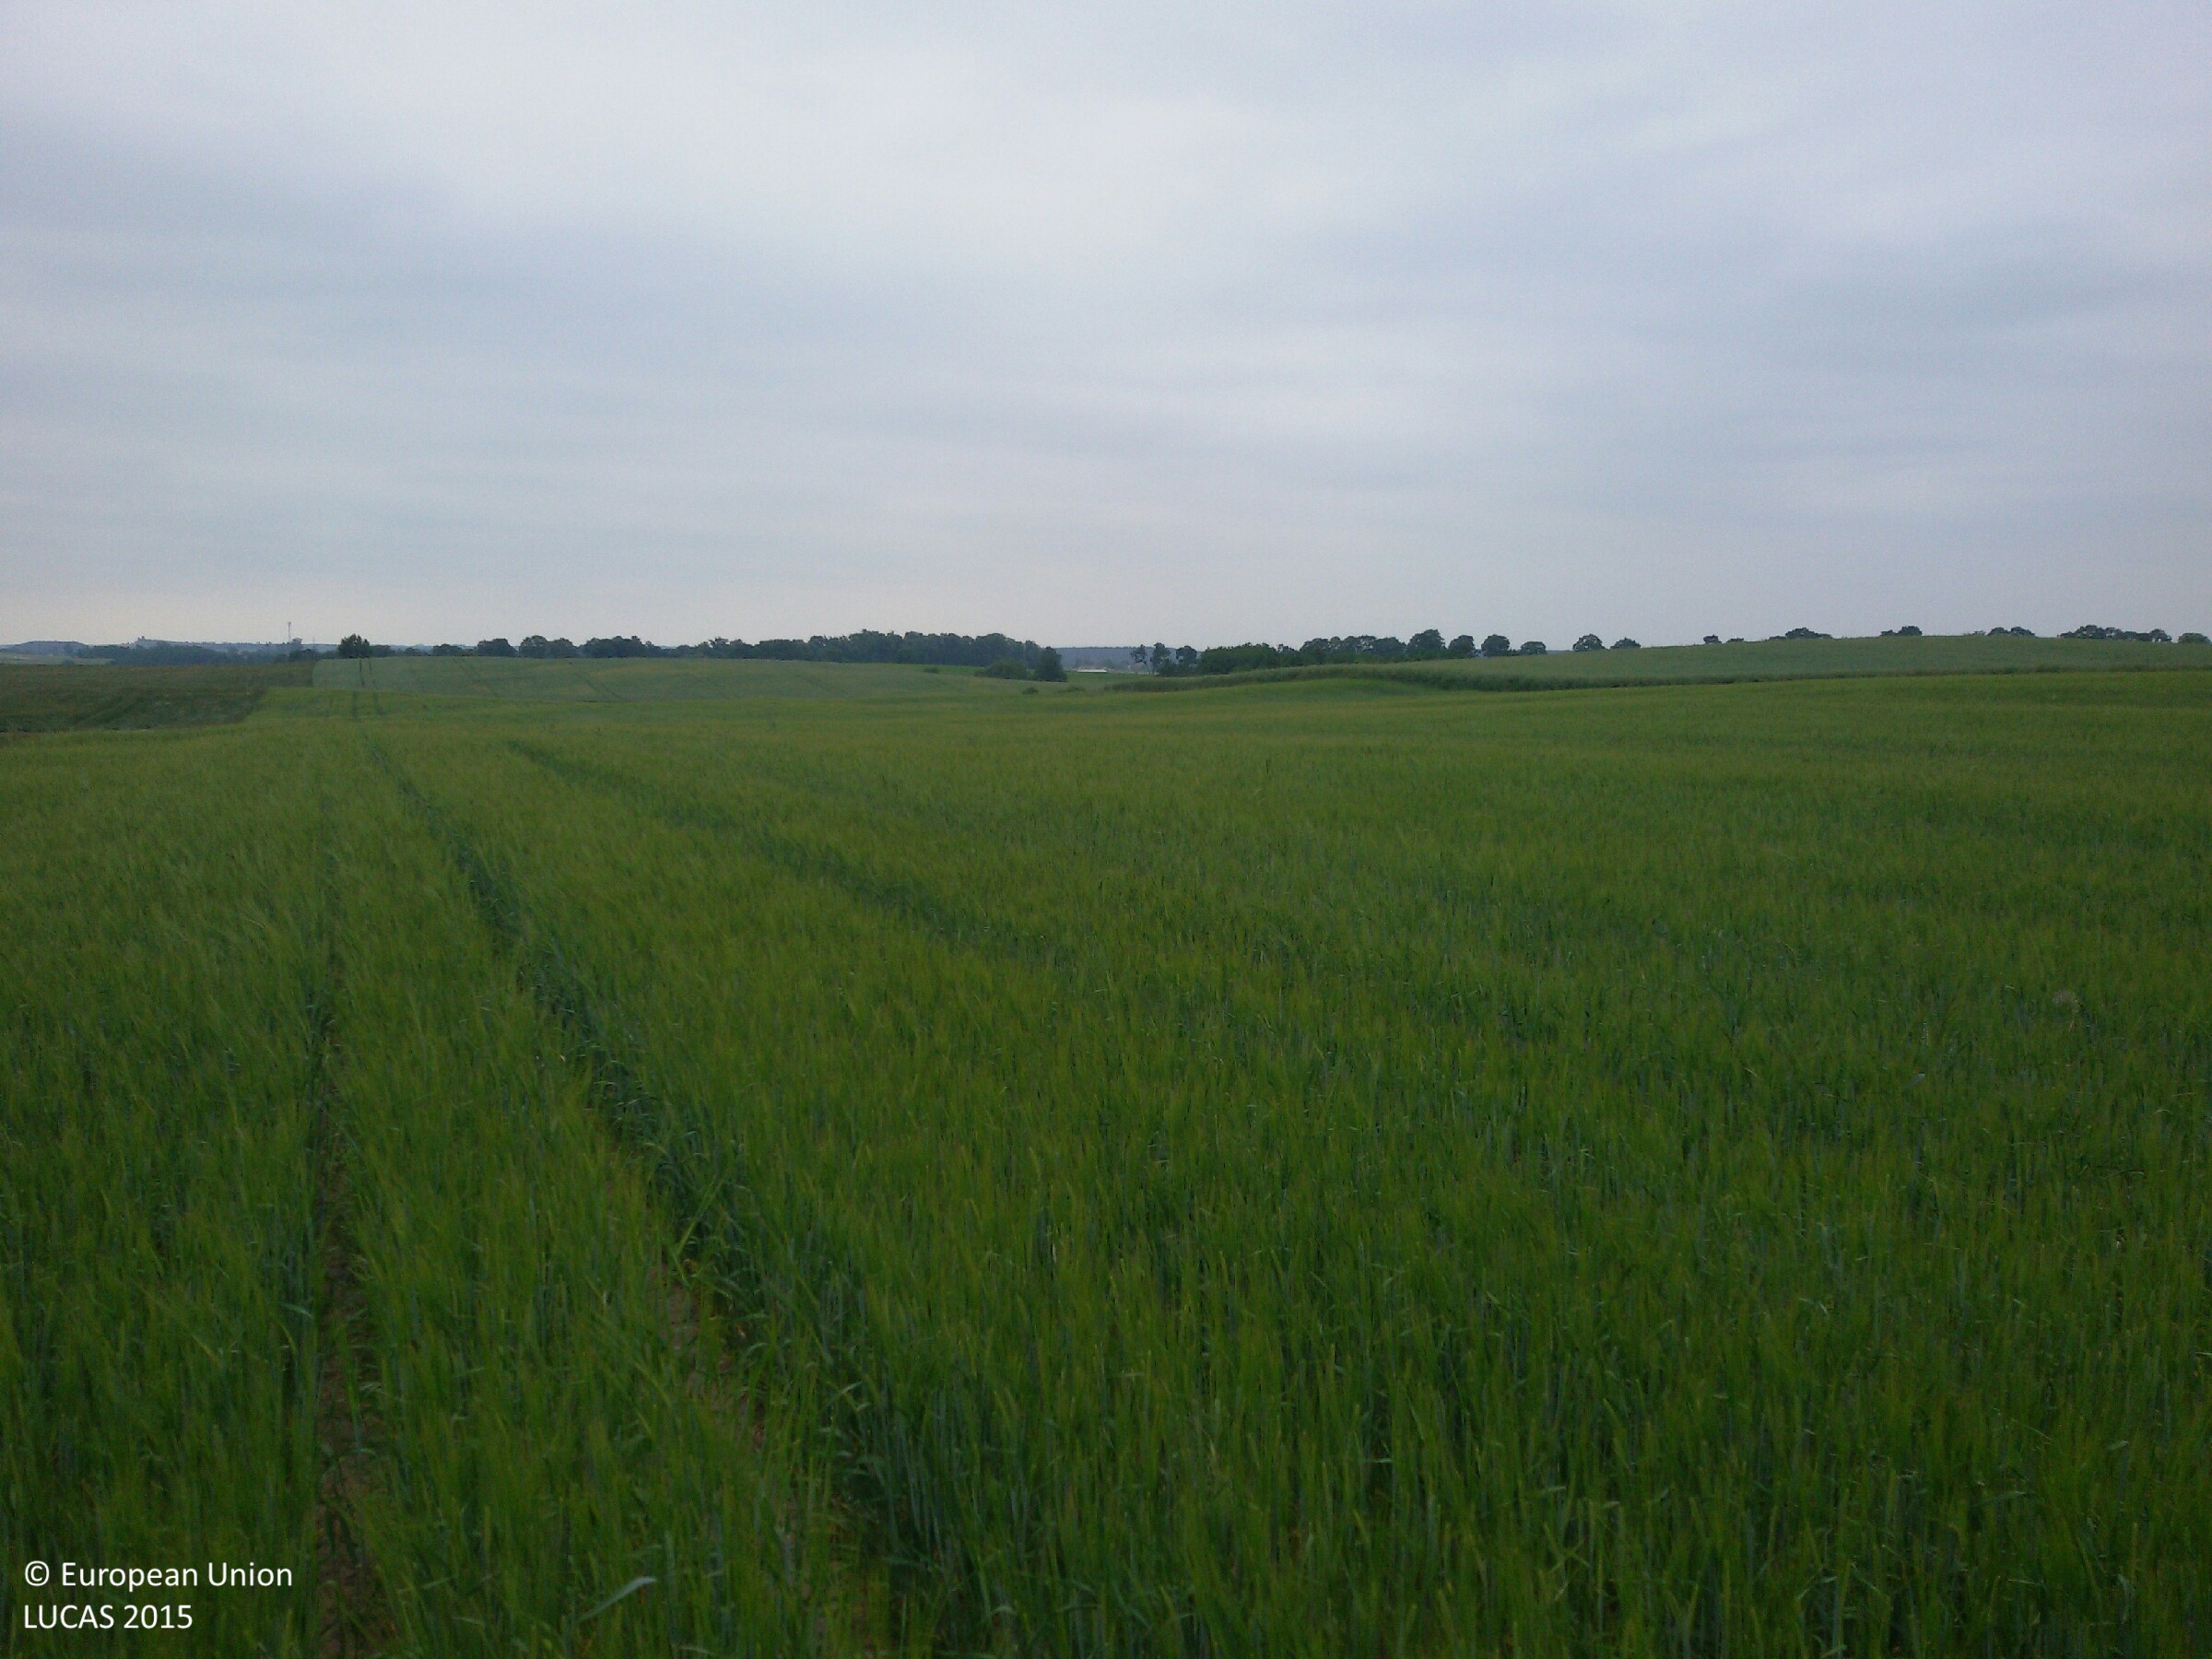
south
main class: Cropland
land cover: Barley
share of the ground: > 75 %
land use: Agriculture (excluding fallow land and kitchen gardens)
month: June
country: PL
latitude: 53.5009
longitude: 19.2356
